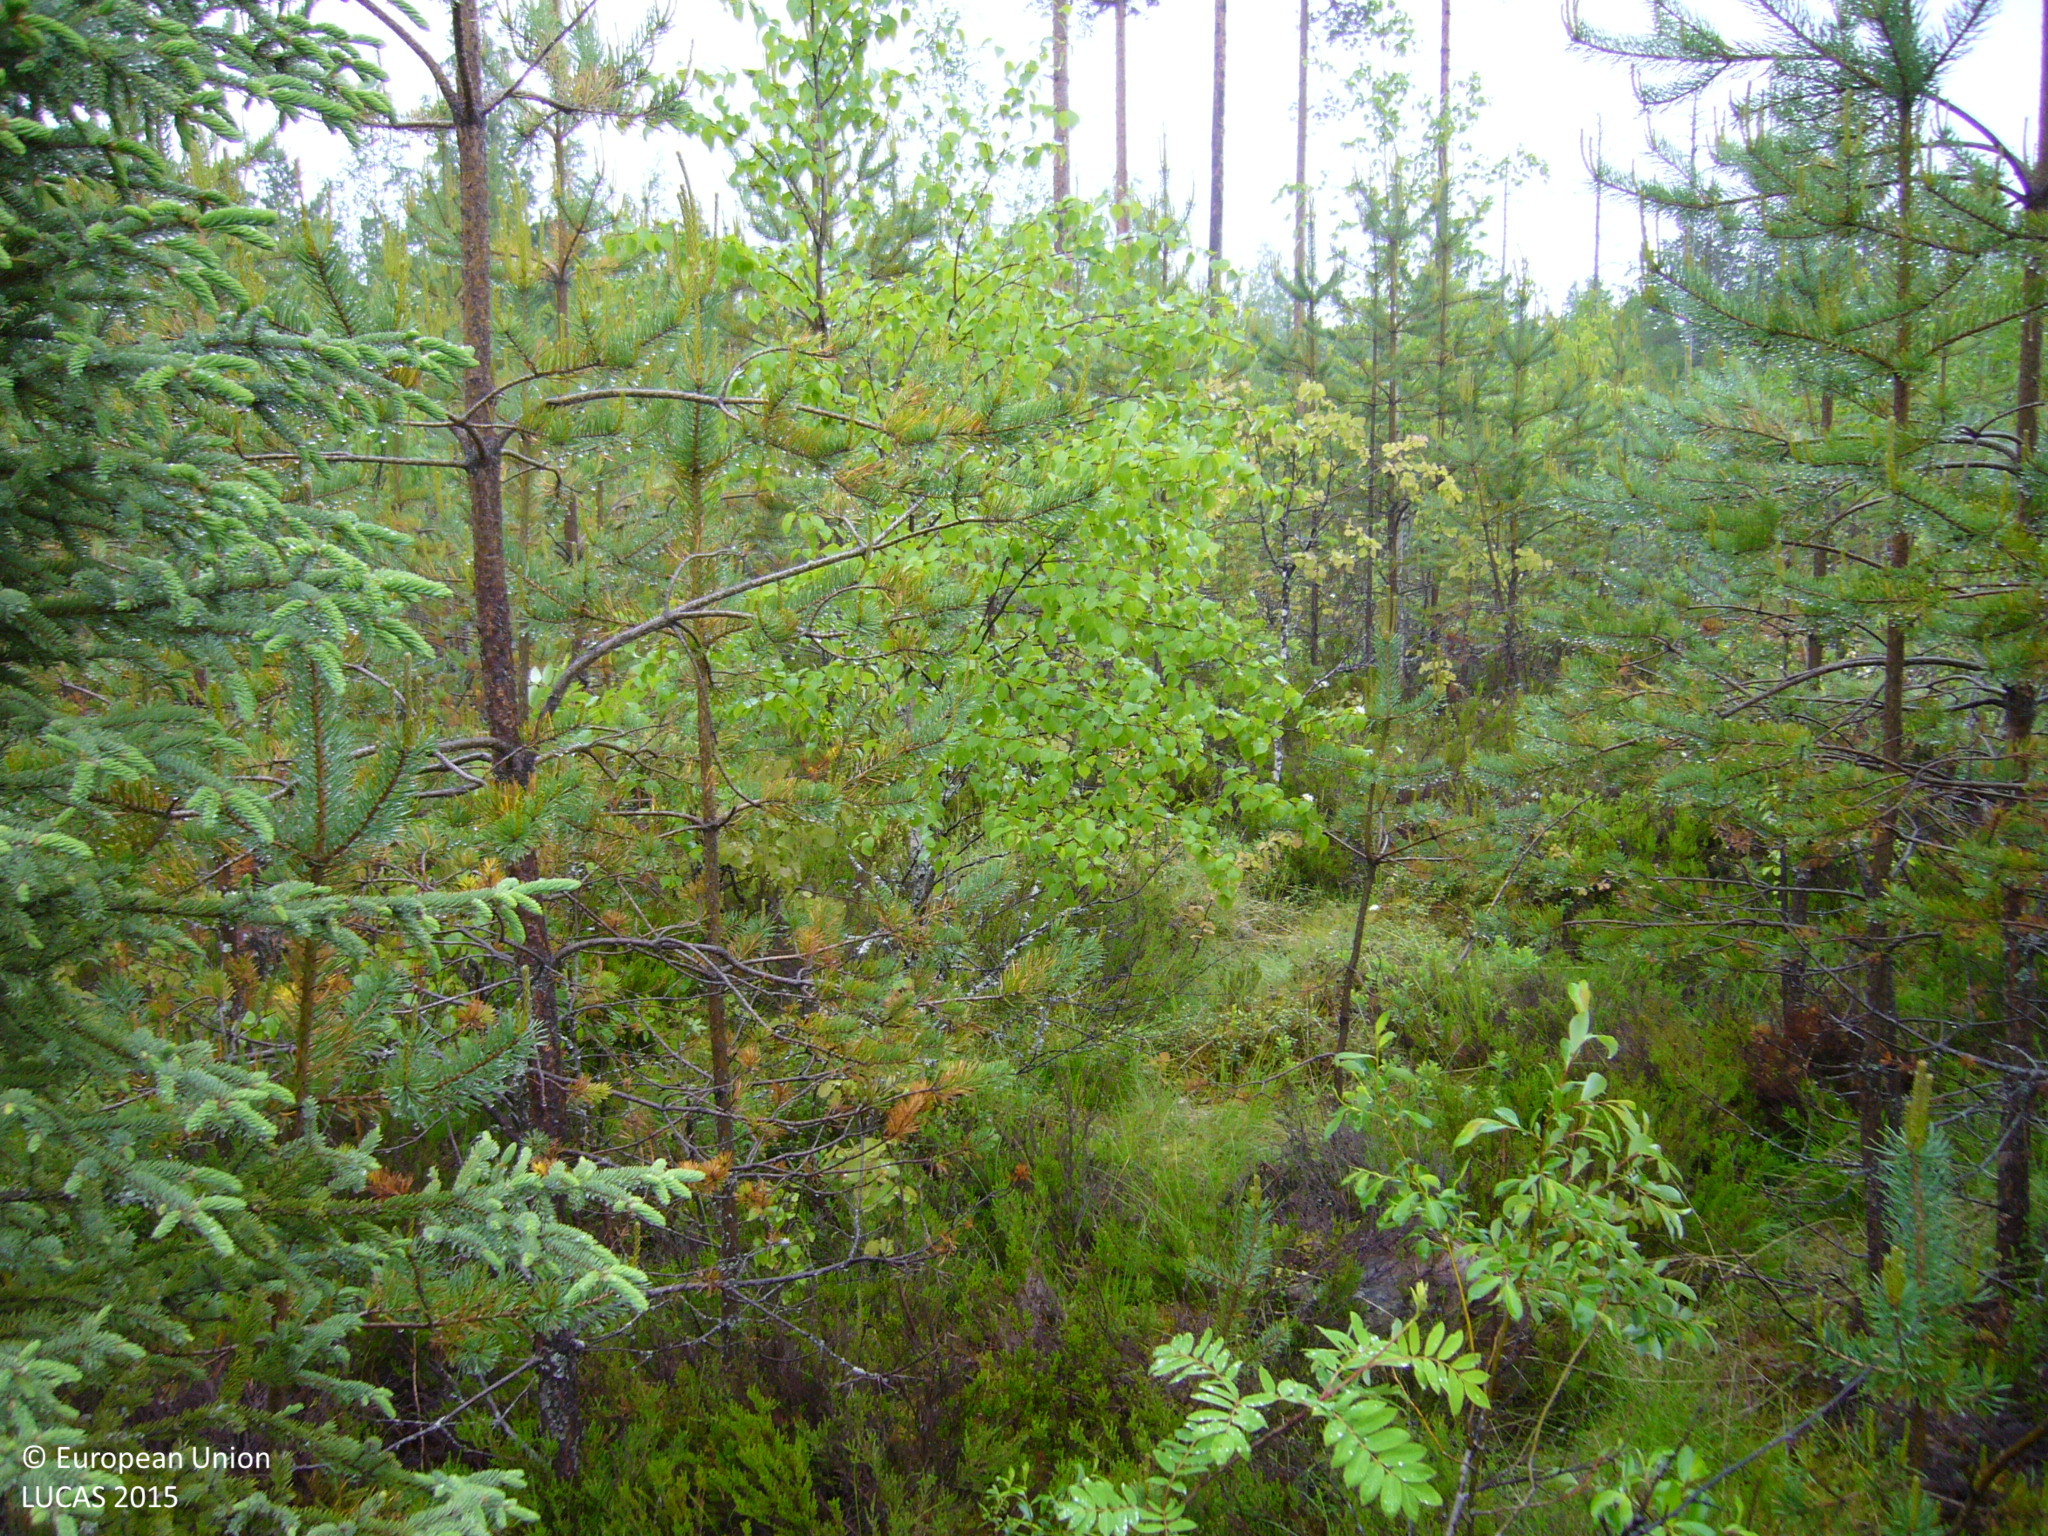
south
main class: Woodland
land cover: Pine dominated mixed woodland
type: boreal forest
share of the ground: 50 - 75 %
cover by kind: shrubs 45 %, coniferous forest trees 30 %, broadleaved forest trees 25 %
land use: Forestry
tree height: < 5 m
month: June
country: FI
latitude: 63.8112
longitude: 24.9728
